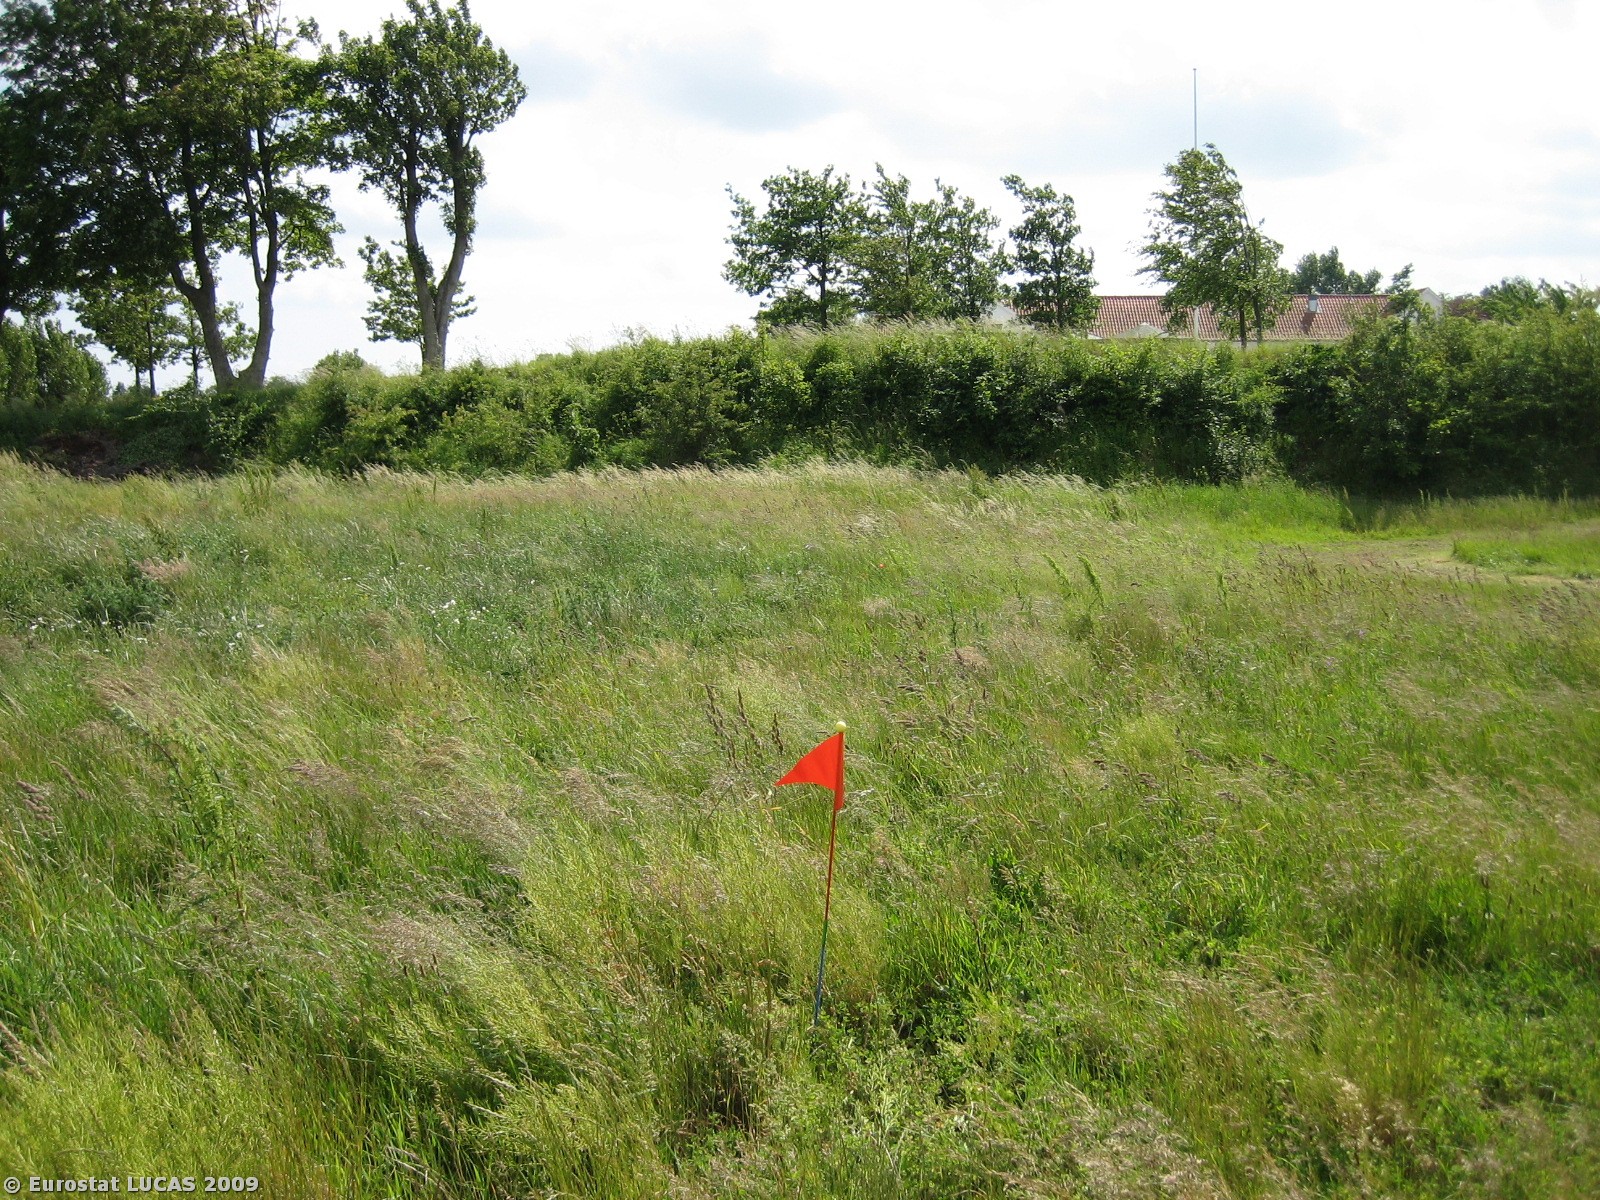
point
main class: Grassland
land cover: Grassland without tree/shrub cover
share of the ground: > 75 %
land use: Amenities, museums, leisure
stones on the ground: 25 - 50 %
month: June
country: DK
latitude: 55.8282
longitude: 10.0160
